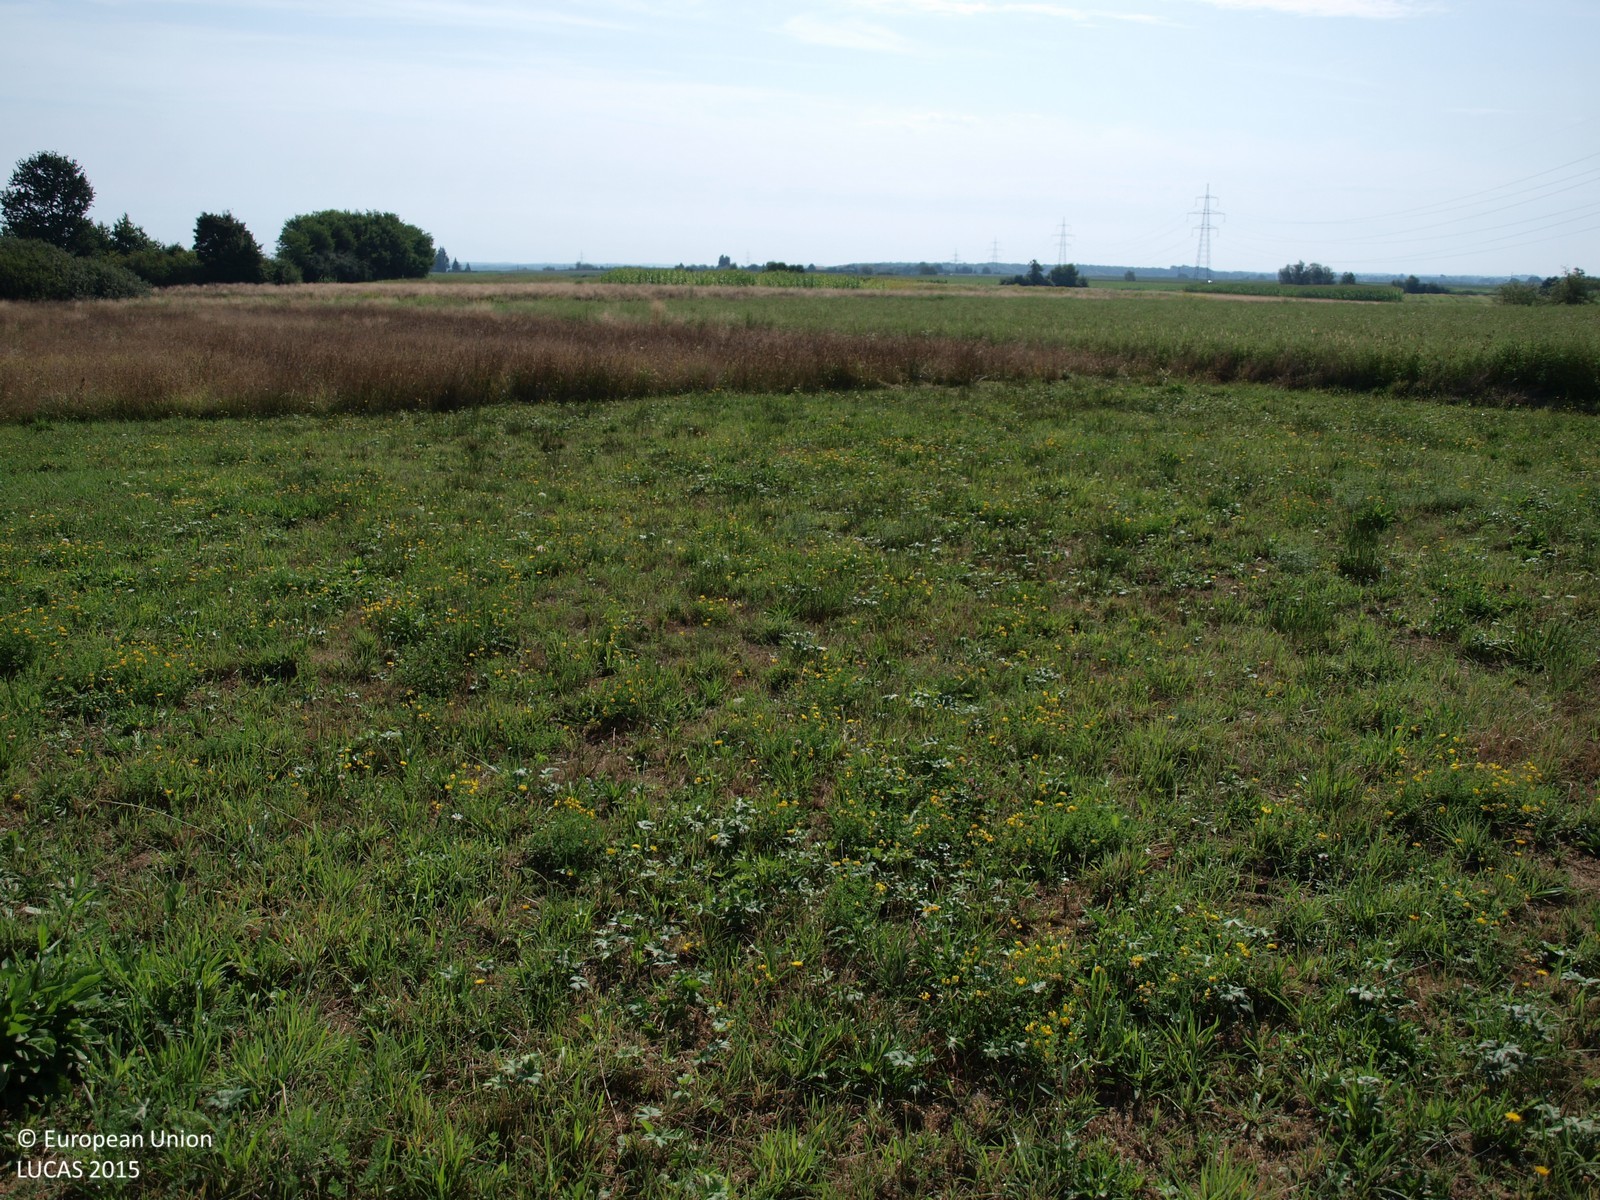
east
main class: Grassland
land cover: Grassland without tree/shrub cover
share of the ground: > 75 %
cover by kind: herbaceous plants 100 %
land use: Agriculture (excluding fallow land and kitchen gardens)
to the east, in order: Grassland without tree/shrub cover; Maize; Grassland without tree/shrub cover
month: August
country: HR
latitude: 45.8974
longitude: 16.2497
